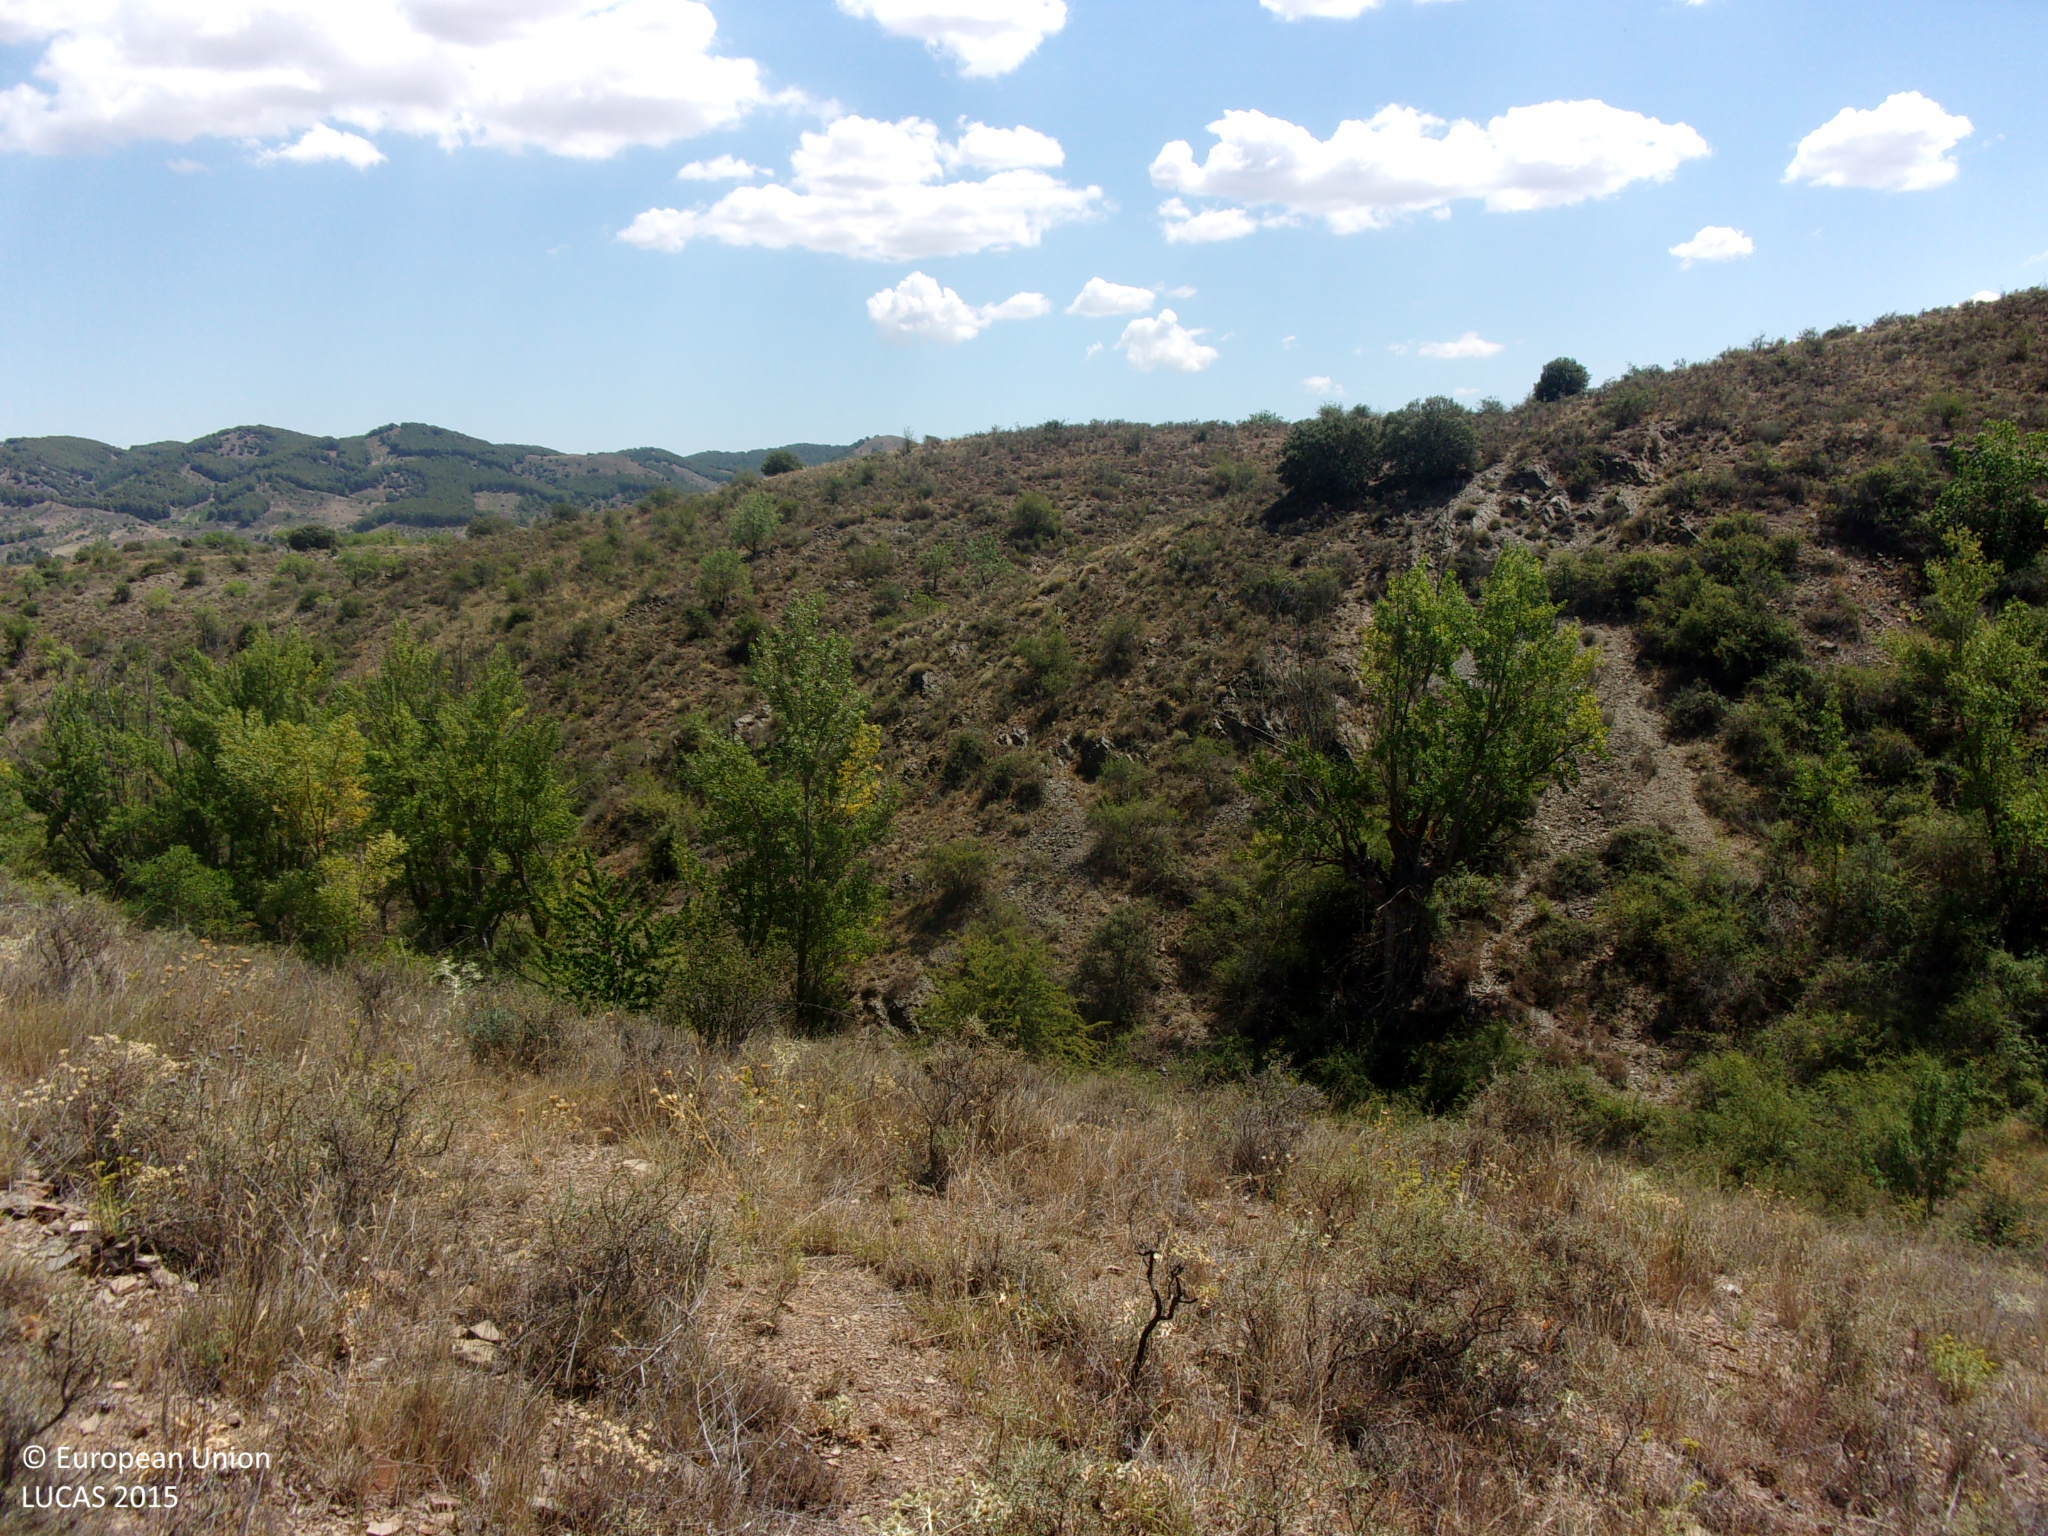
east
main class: Shrubland
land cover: Shrubland without tree cover
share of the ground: > 75 %
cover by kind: shrubs 80 %, herbaceous plants 10 %, consolidated bare surface 10 %
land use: Semi-natural and natural areas not in use
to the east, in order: Shrubland without tree cover; Groves; Shrubland without tree cover; Vineyards
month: July
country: ES
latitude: 41.0112
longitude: -1.3510
